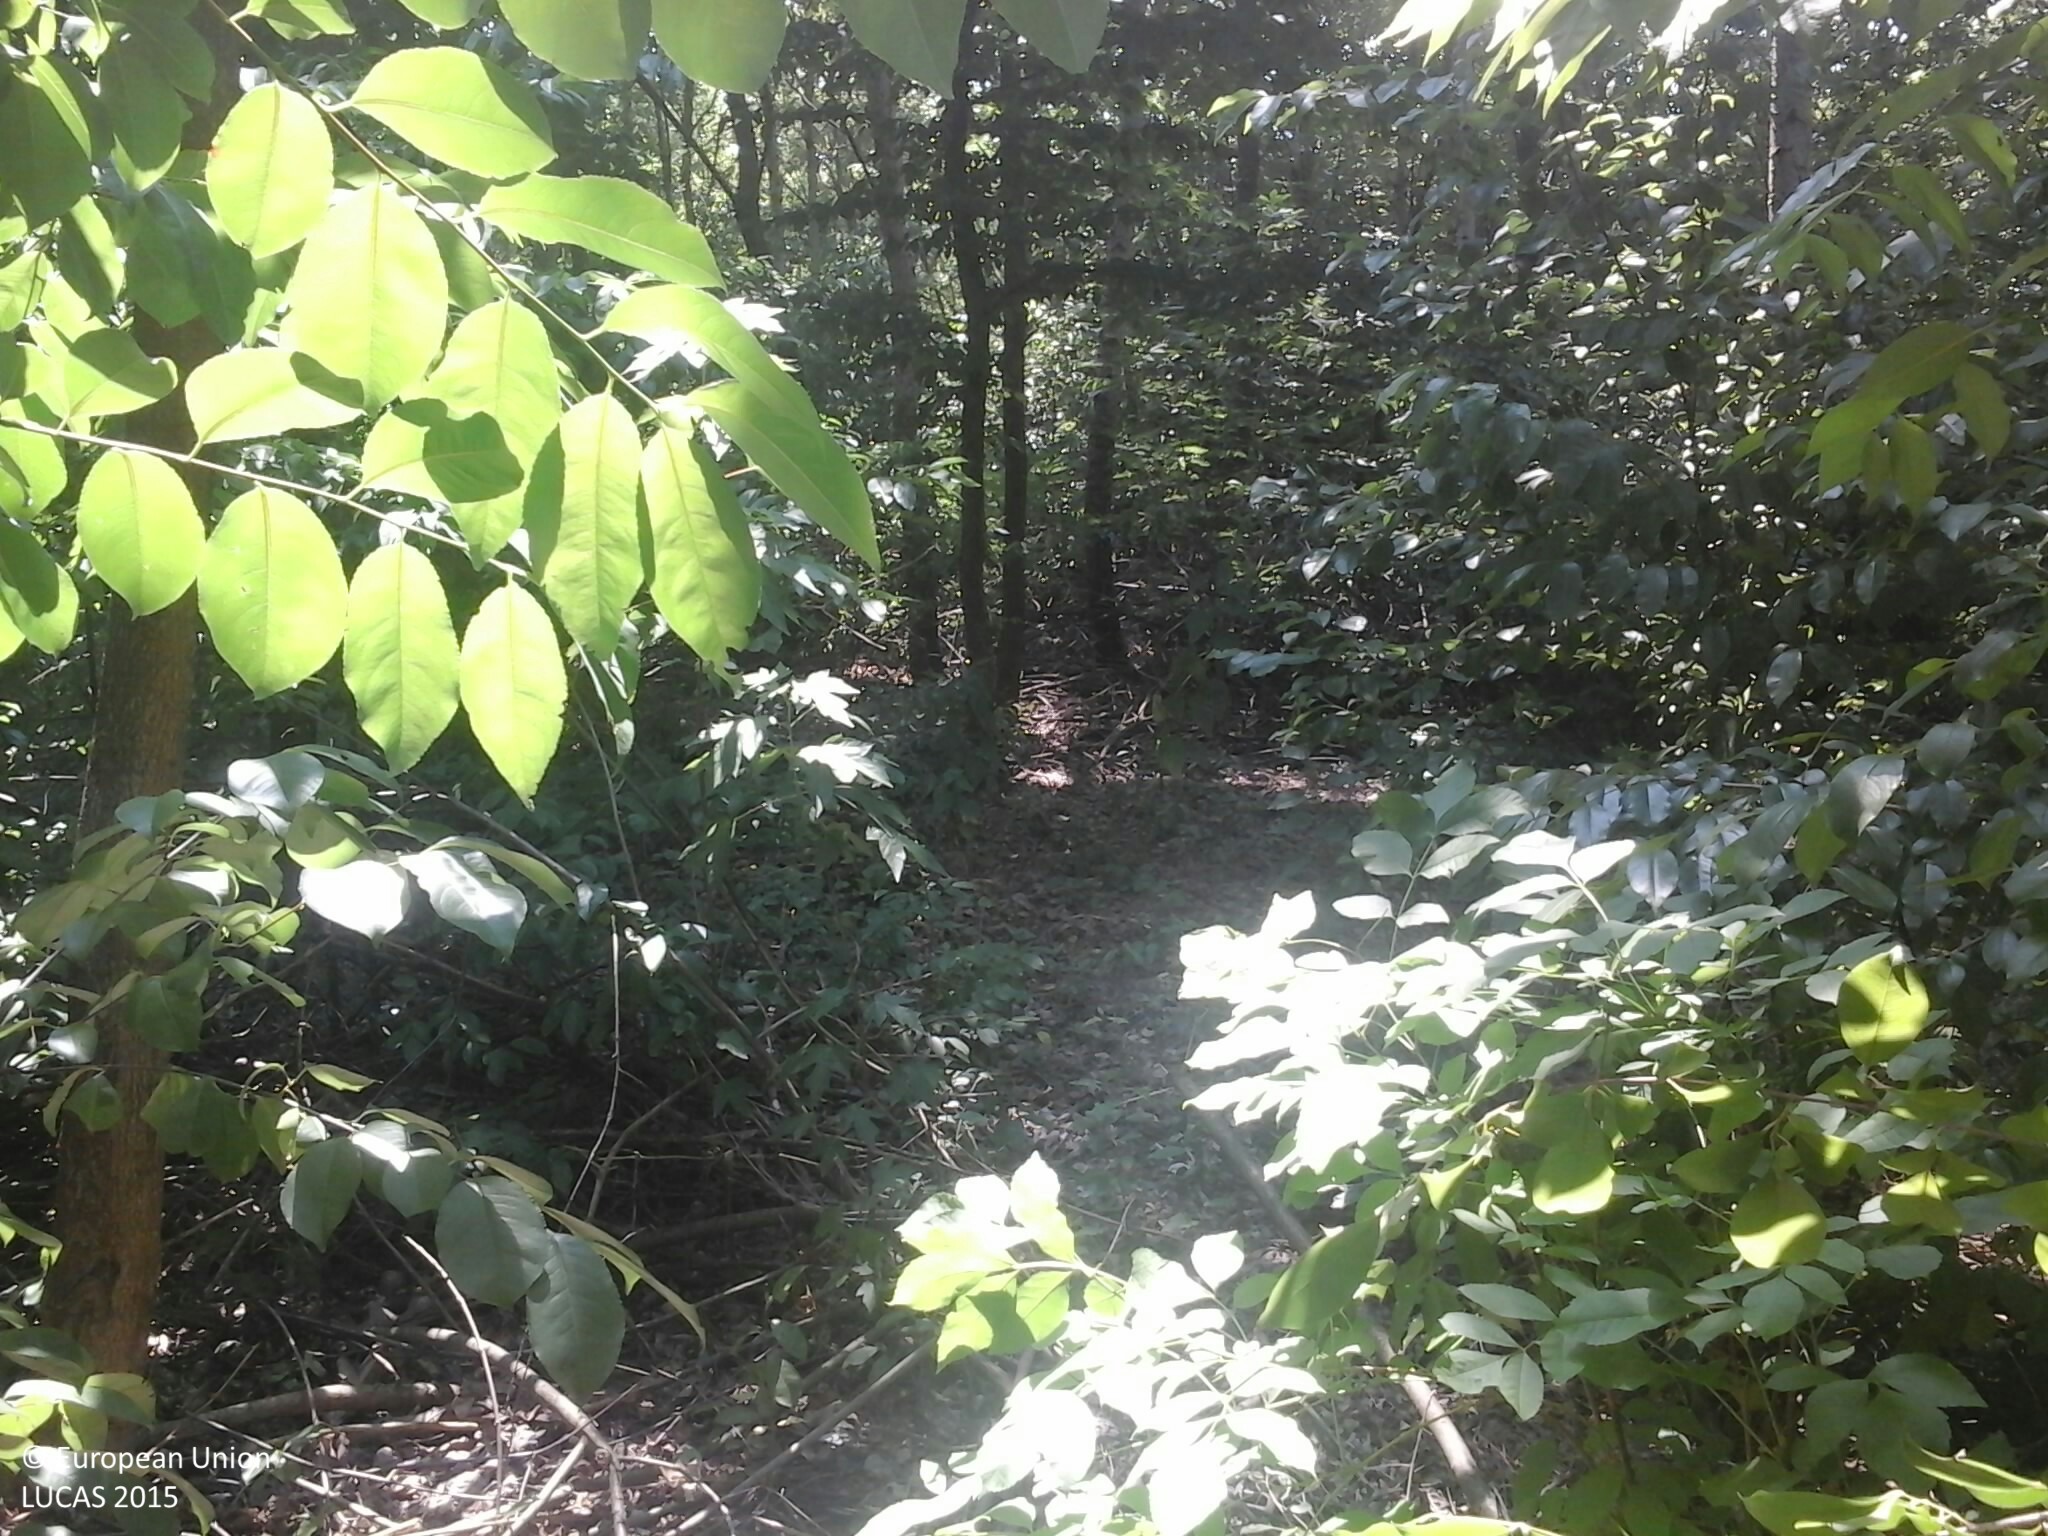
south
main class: Woodland
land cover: Broadleaved woodland
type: mesophytic deciduous forest
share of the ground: > 75 %
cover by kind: broadleaved forest trees 95 %, herbaceous plants 5 %
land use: Forestry
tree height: > 5 m
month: July
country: HU
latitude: 47.6689
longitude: 22.0505
